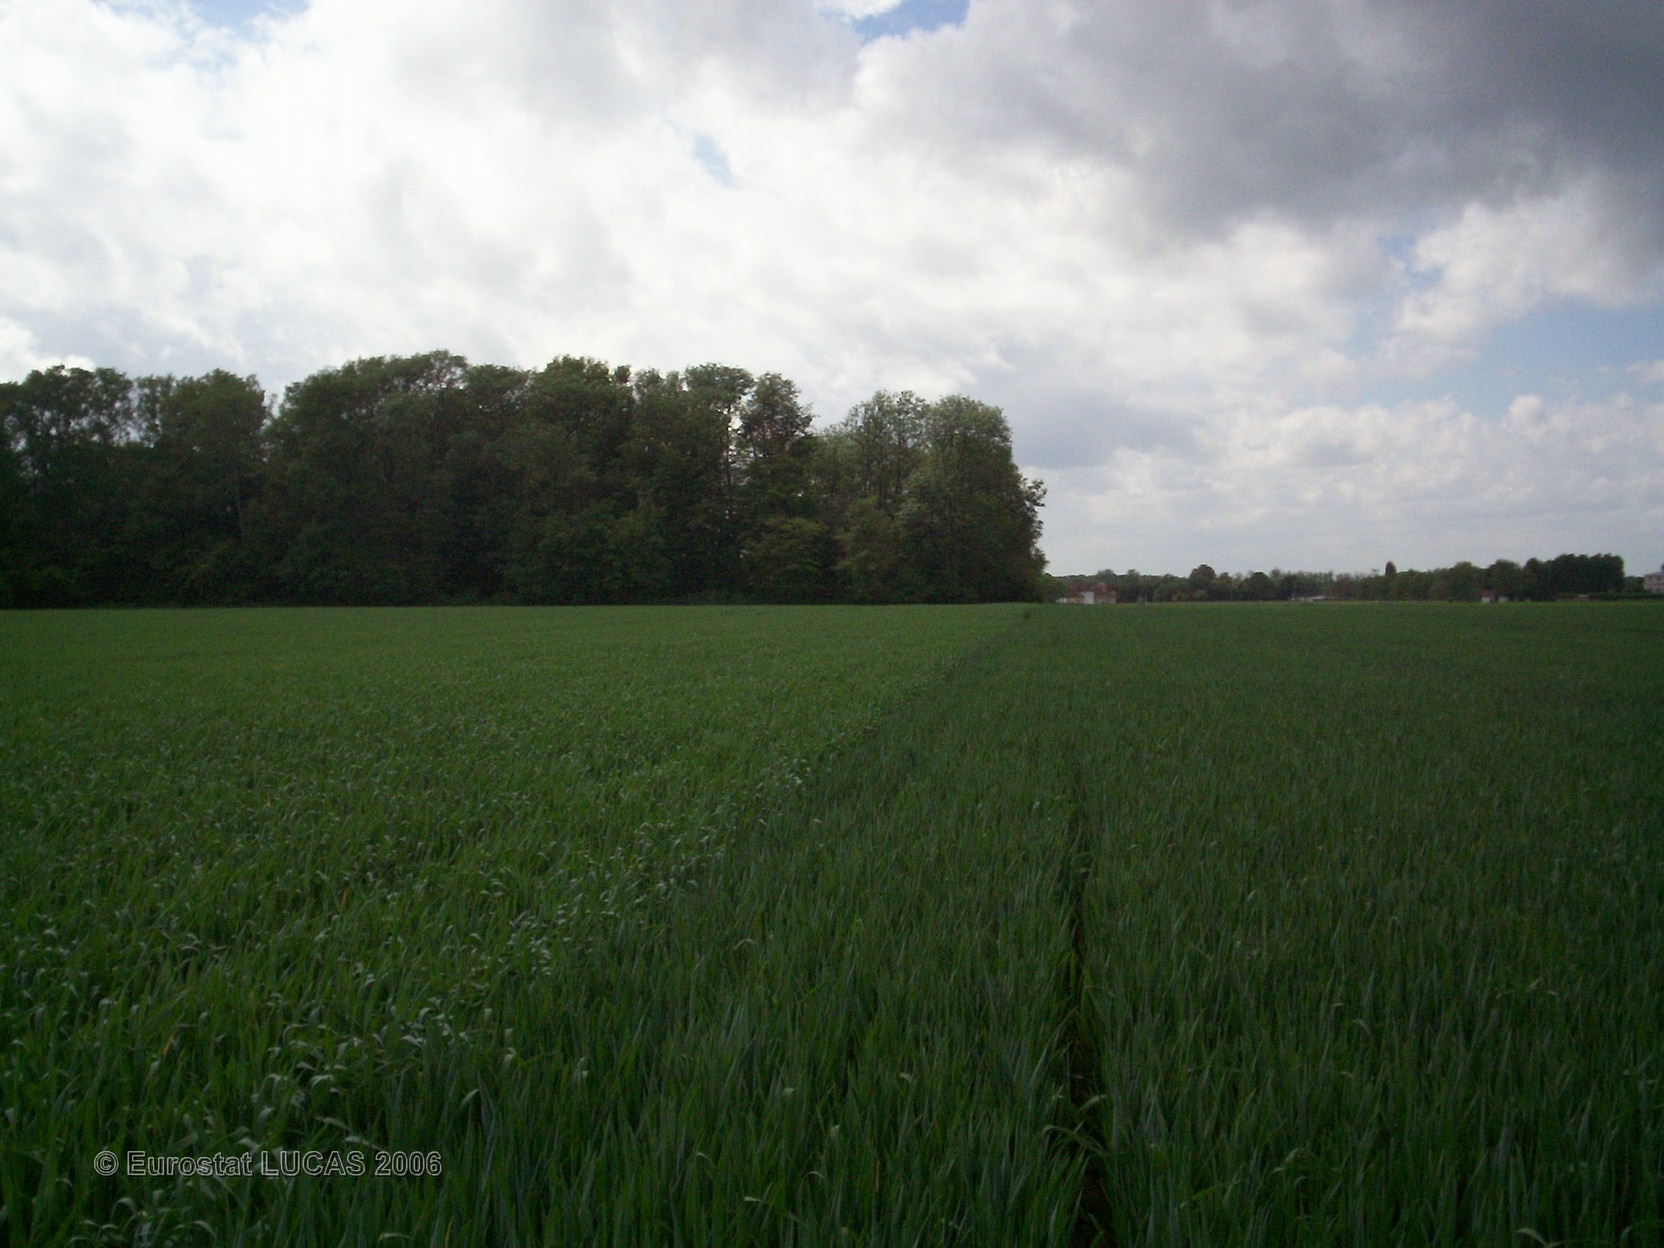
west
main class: Cropland
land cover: Common wheat
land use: Agriculture (excluding fallow land and kitchen gardens)
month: May
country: FR
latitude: 48.7267
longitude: 2.7717
